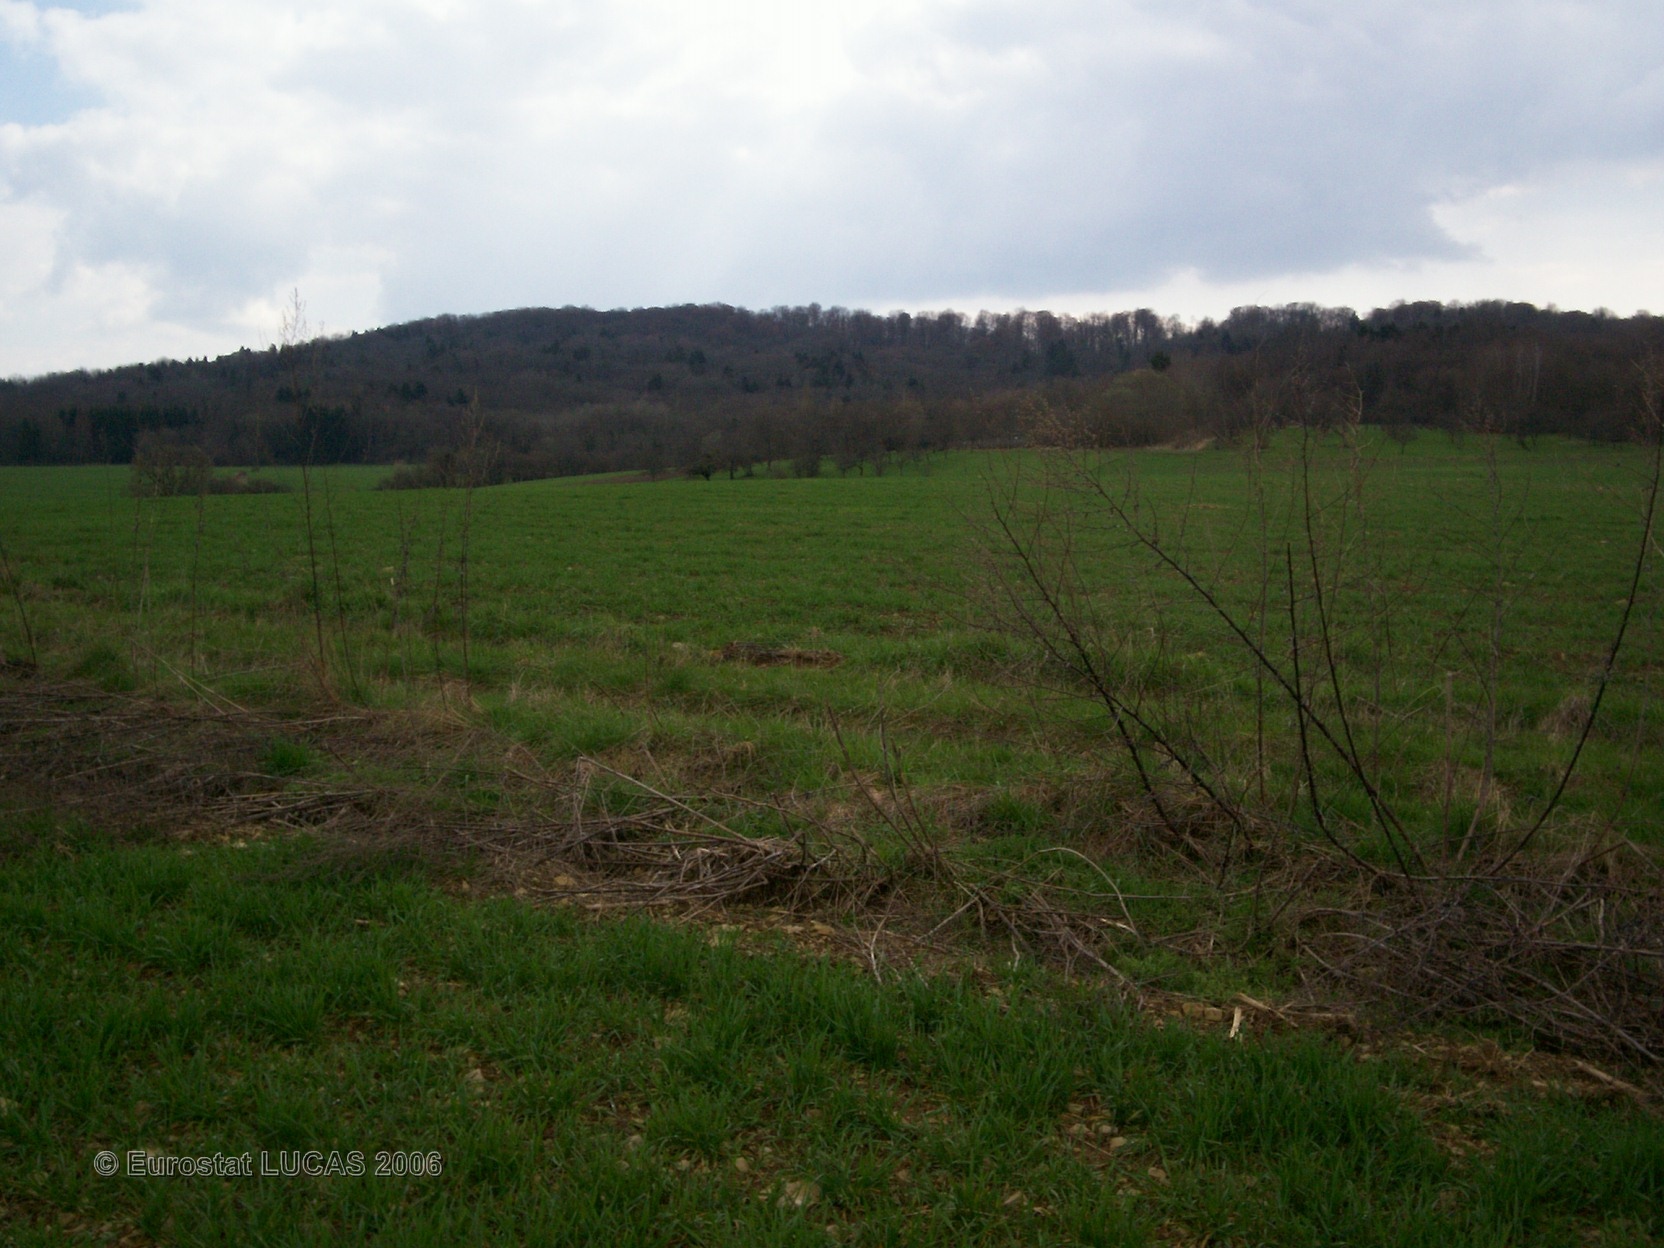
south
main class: Cropland
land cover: Common wheat
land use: Agriculture (excluding fallow land and kitchen gardens)
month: April
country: FR
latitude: 47.7491
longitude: 6.3599
